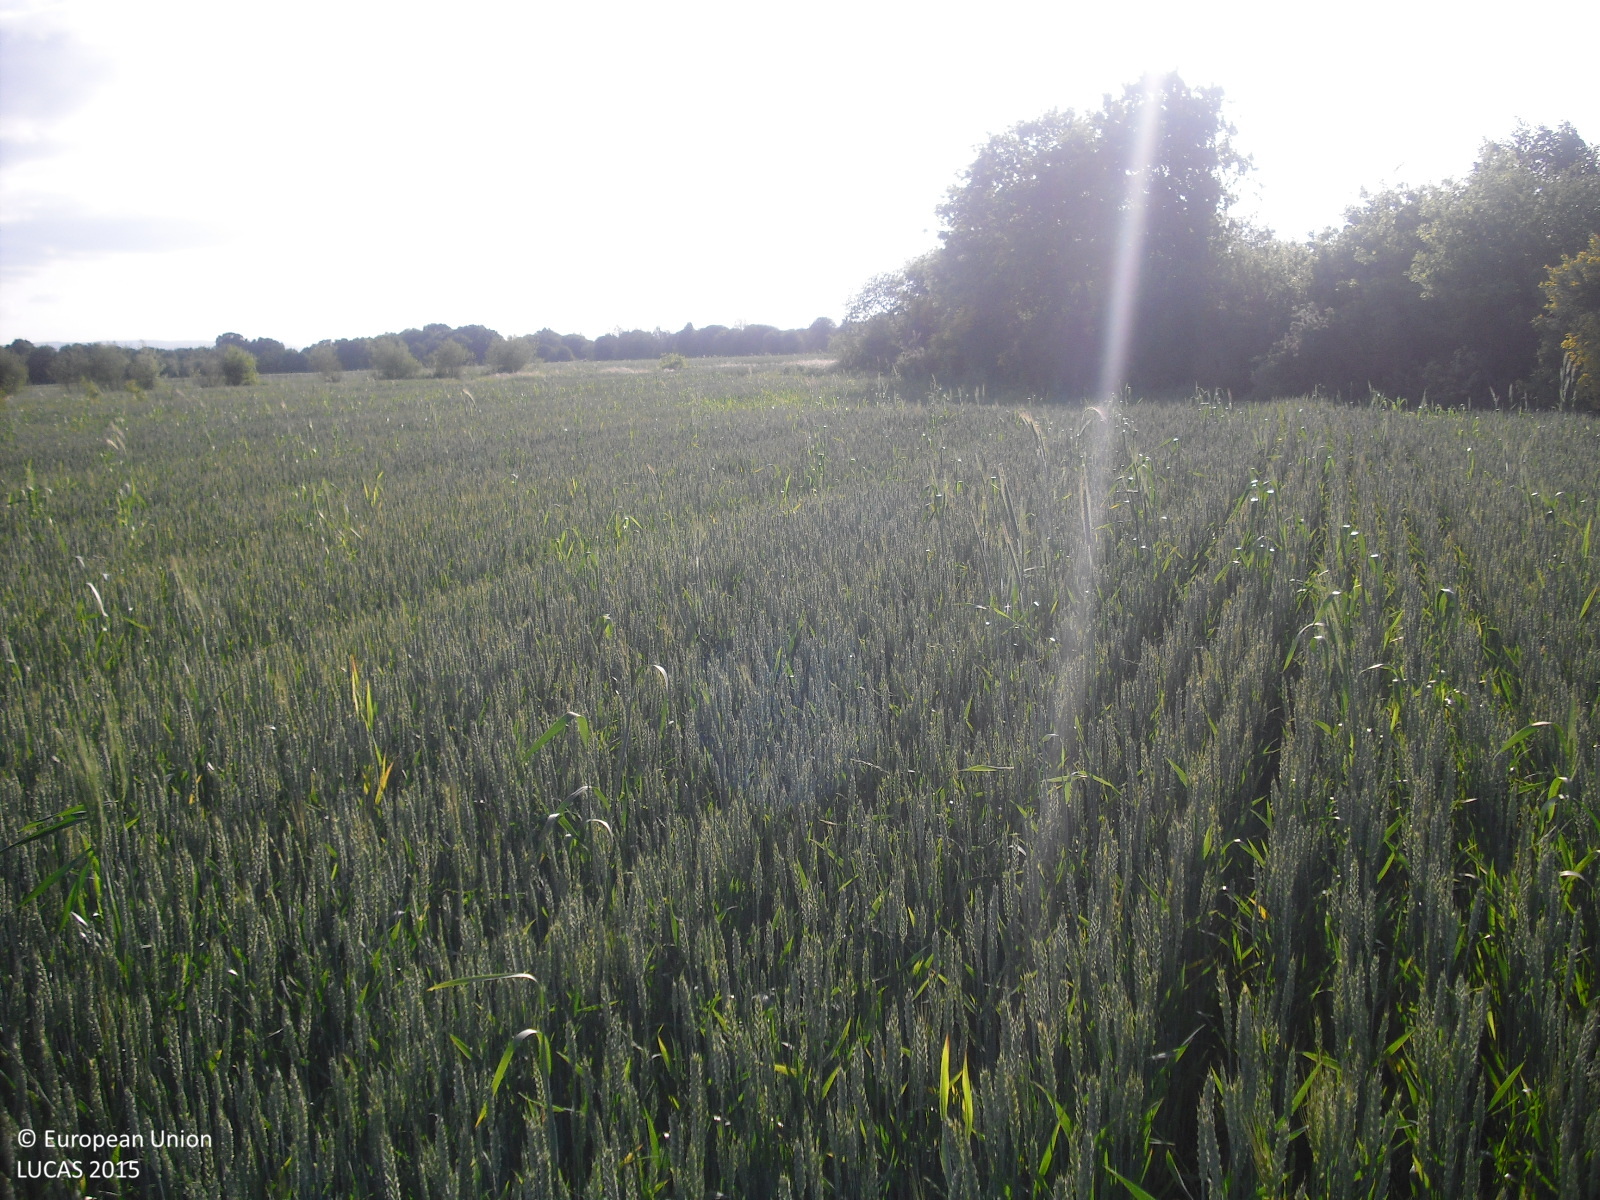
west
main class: Cropland
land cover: Common wheat
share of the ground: > 75 %
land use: Agriculture (excluding fallow land and kitchen gardens)
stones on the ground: < 10 %
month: May
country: ES
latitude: 42.0666
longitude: -7.6517
